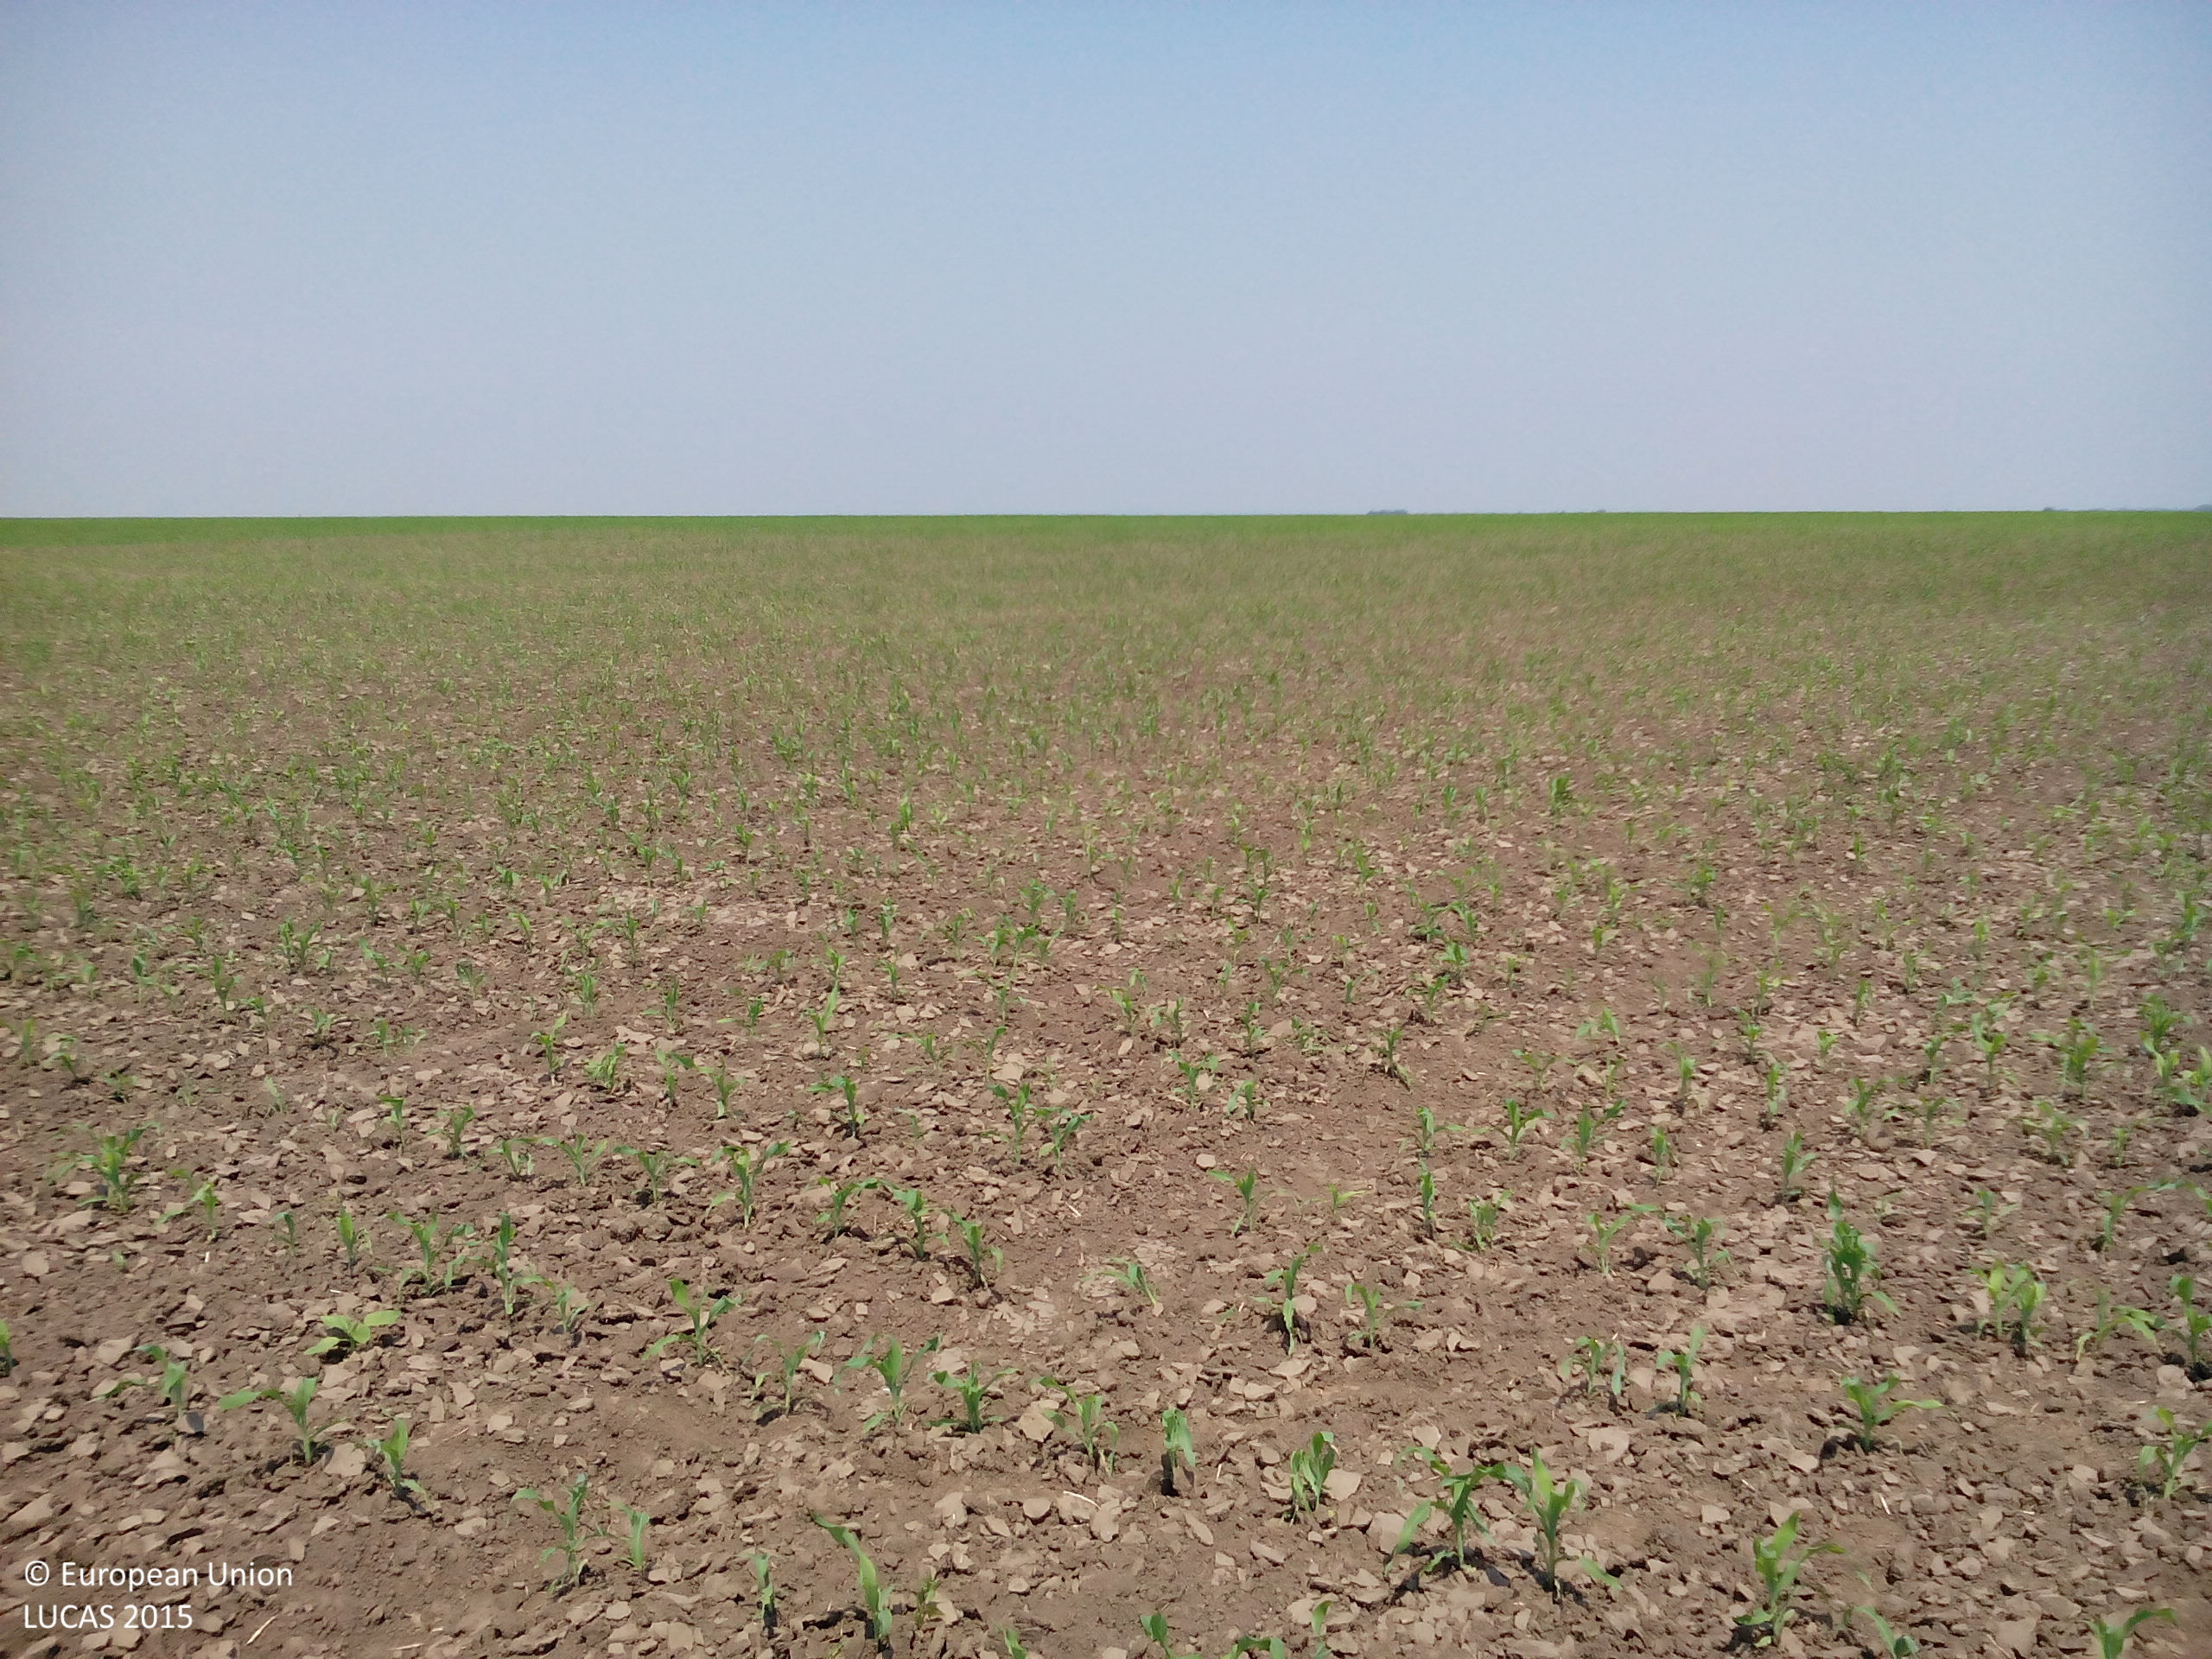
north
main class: Cropland
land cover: Maize
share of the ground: 10 - 25 %
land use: Agriculture (excluding fallow land and kitchen gardens)
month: May
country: BG
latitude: 43.6062
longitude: 24.0671
